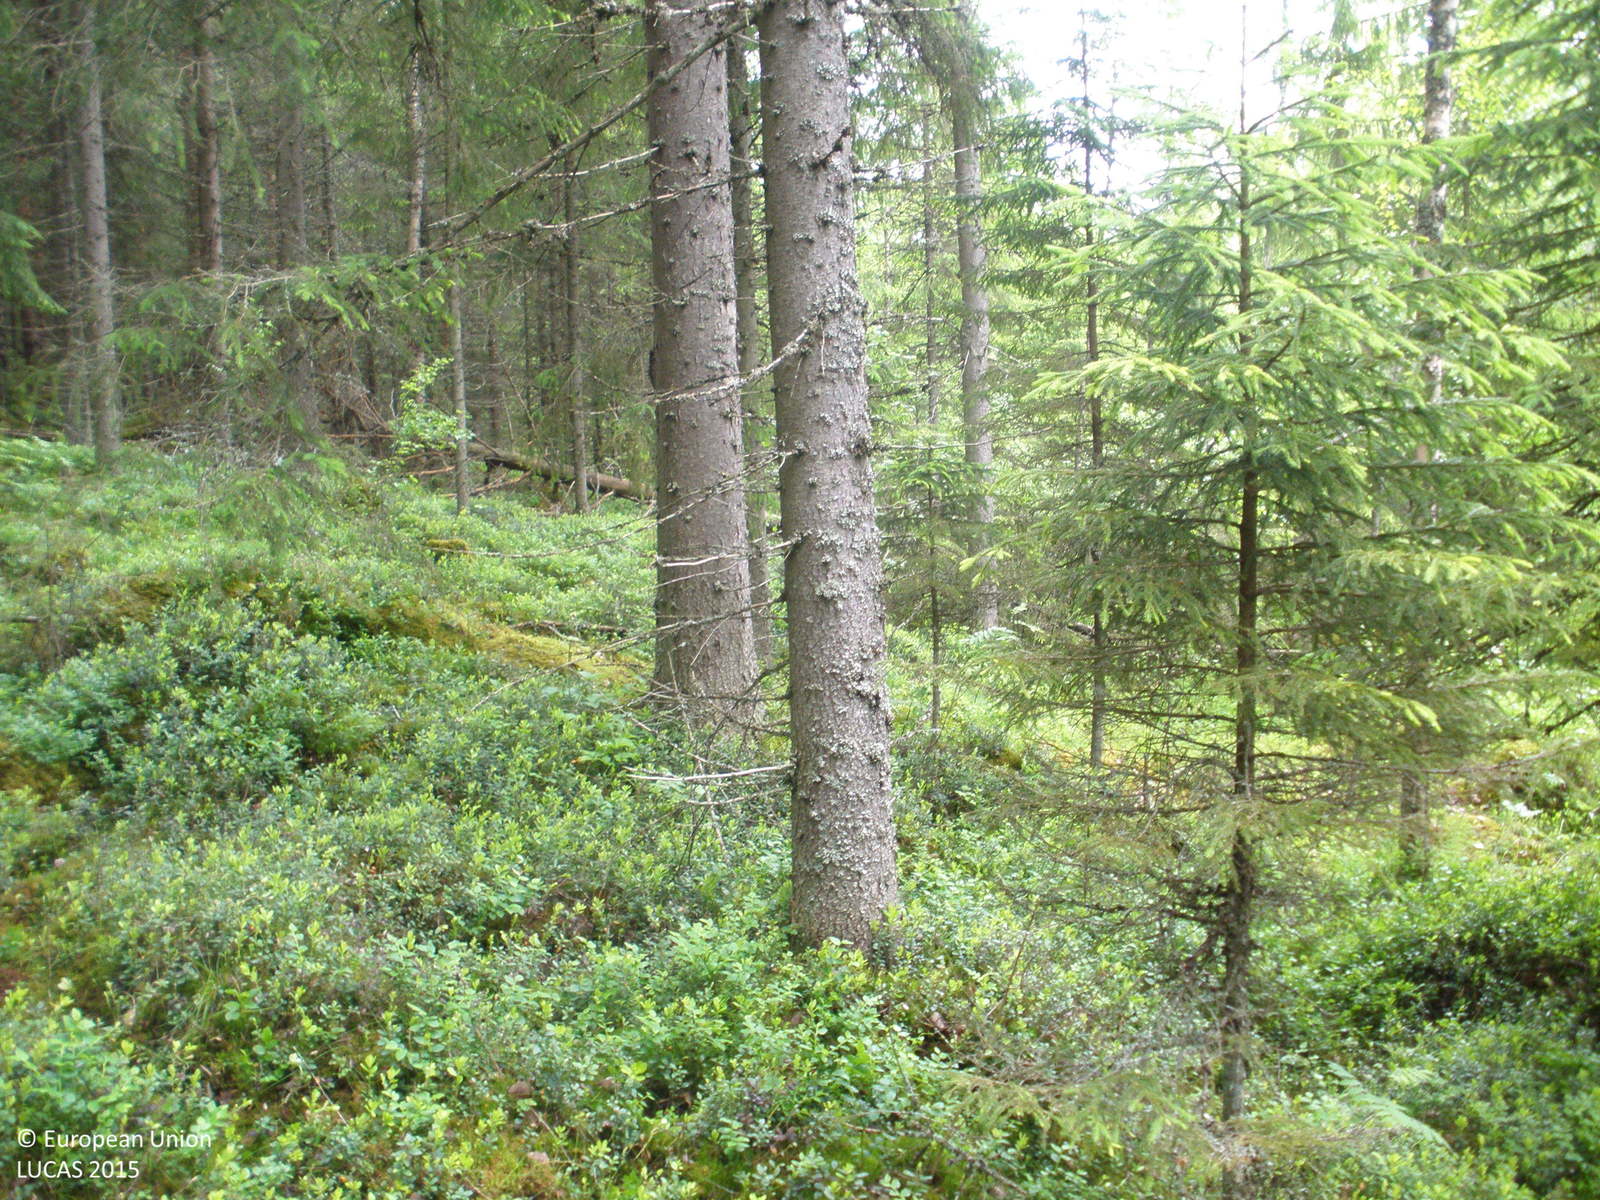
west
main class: Woodland
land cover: Spruce dominated coniferous woodland
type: boreal forest
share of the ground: > 75 %
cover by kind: coniferous forest trees 85 %, lichens and mosses 10 %, herbaceous plants 5 %
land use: Forestry
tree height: > 5 m
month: June
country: FI
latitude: 61.0222
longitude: 23.5735
